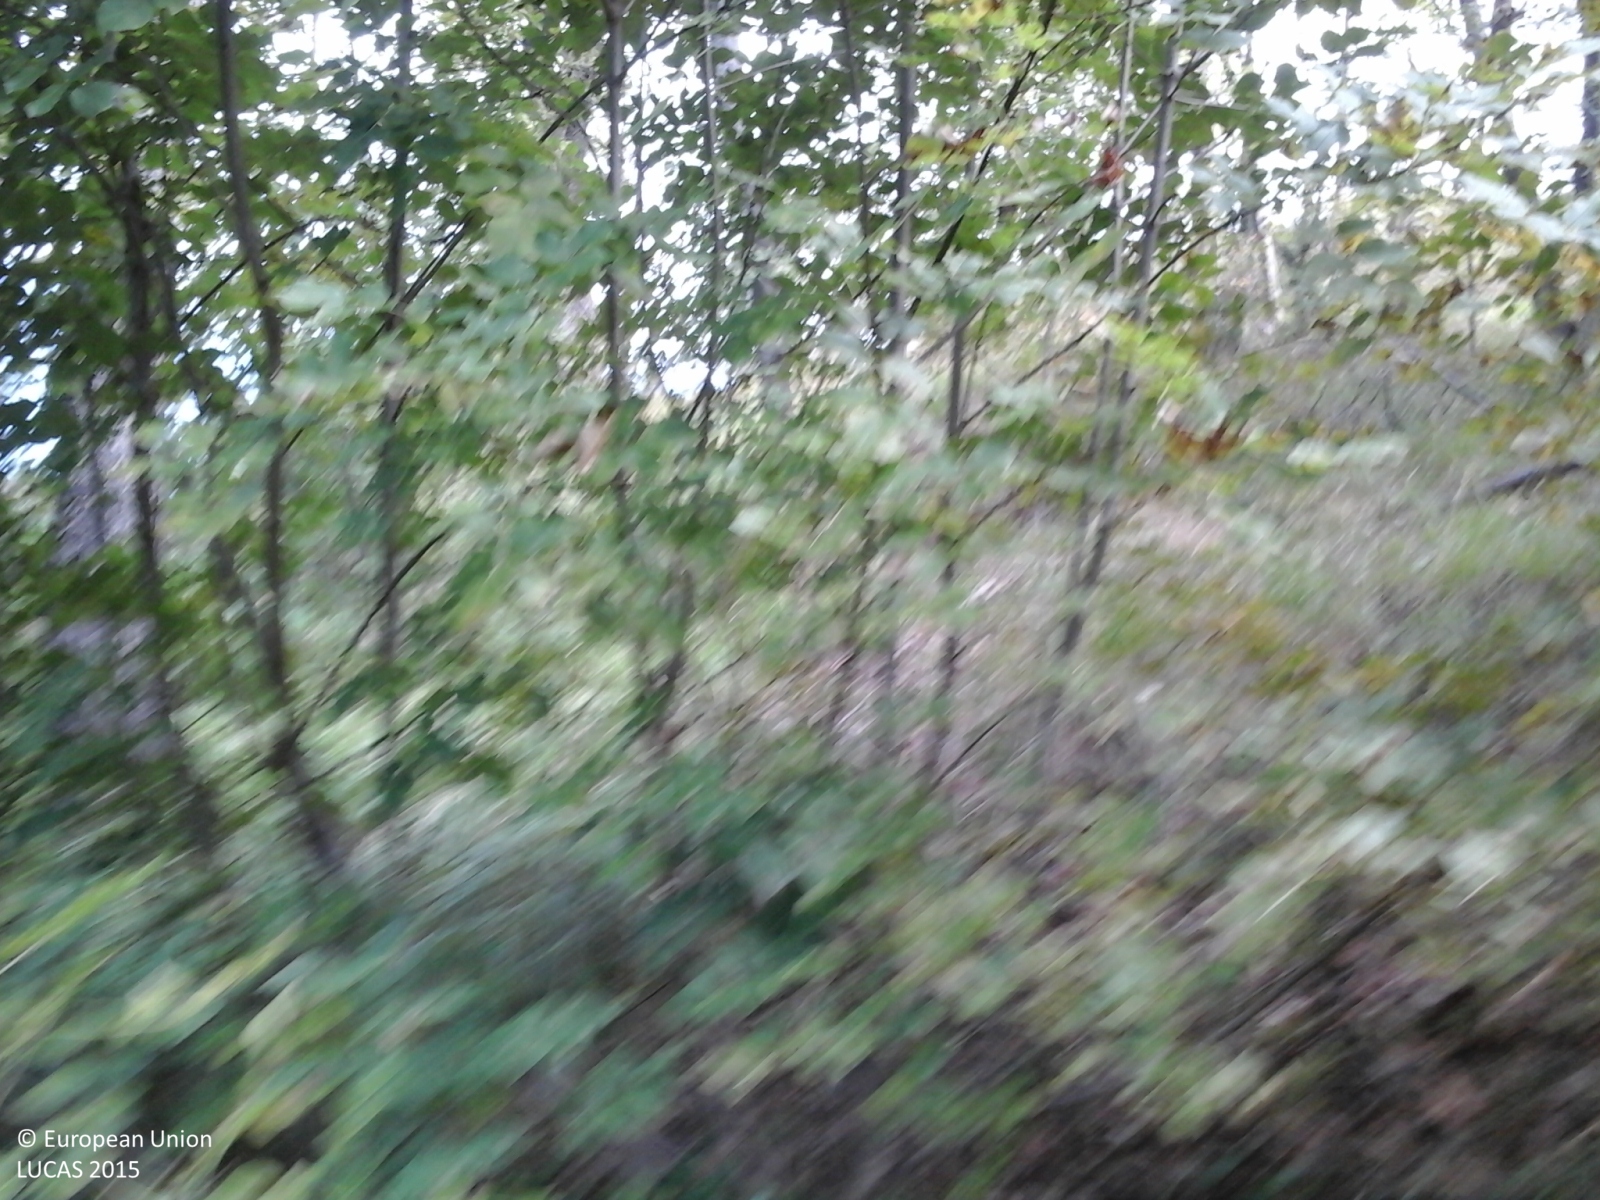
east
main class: Woodland
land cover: Broadleaved woodland
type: thermophilous deciduous forest
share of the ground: > 75 %
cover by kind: broadleaved forest trees 70 %, herbaceous plants 20 %, shrubs 10 %
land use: Forestry
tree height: > 5 m
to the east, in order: Broadleaved woodland; Electric lines; Broadleaved woodland; Electric lines; Broadleaved woodland; Paved roads, cycling and walking lanes; Other mixed woodland
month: September
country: IT
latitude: 44.4466
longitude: 8.4077
